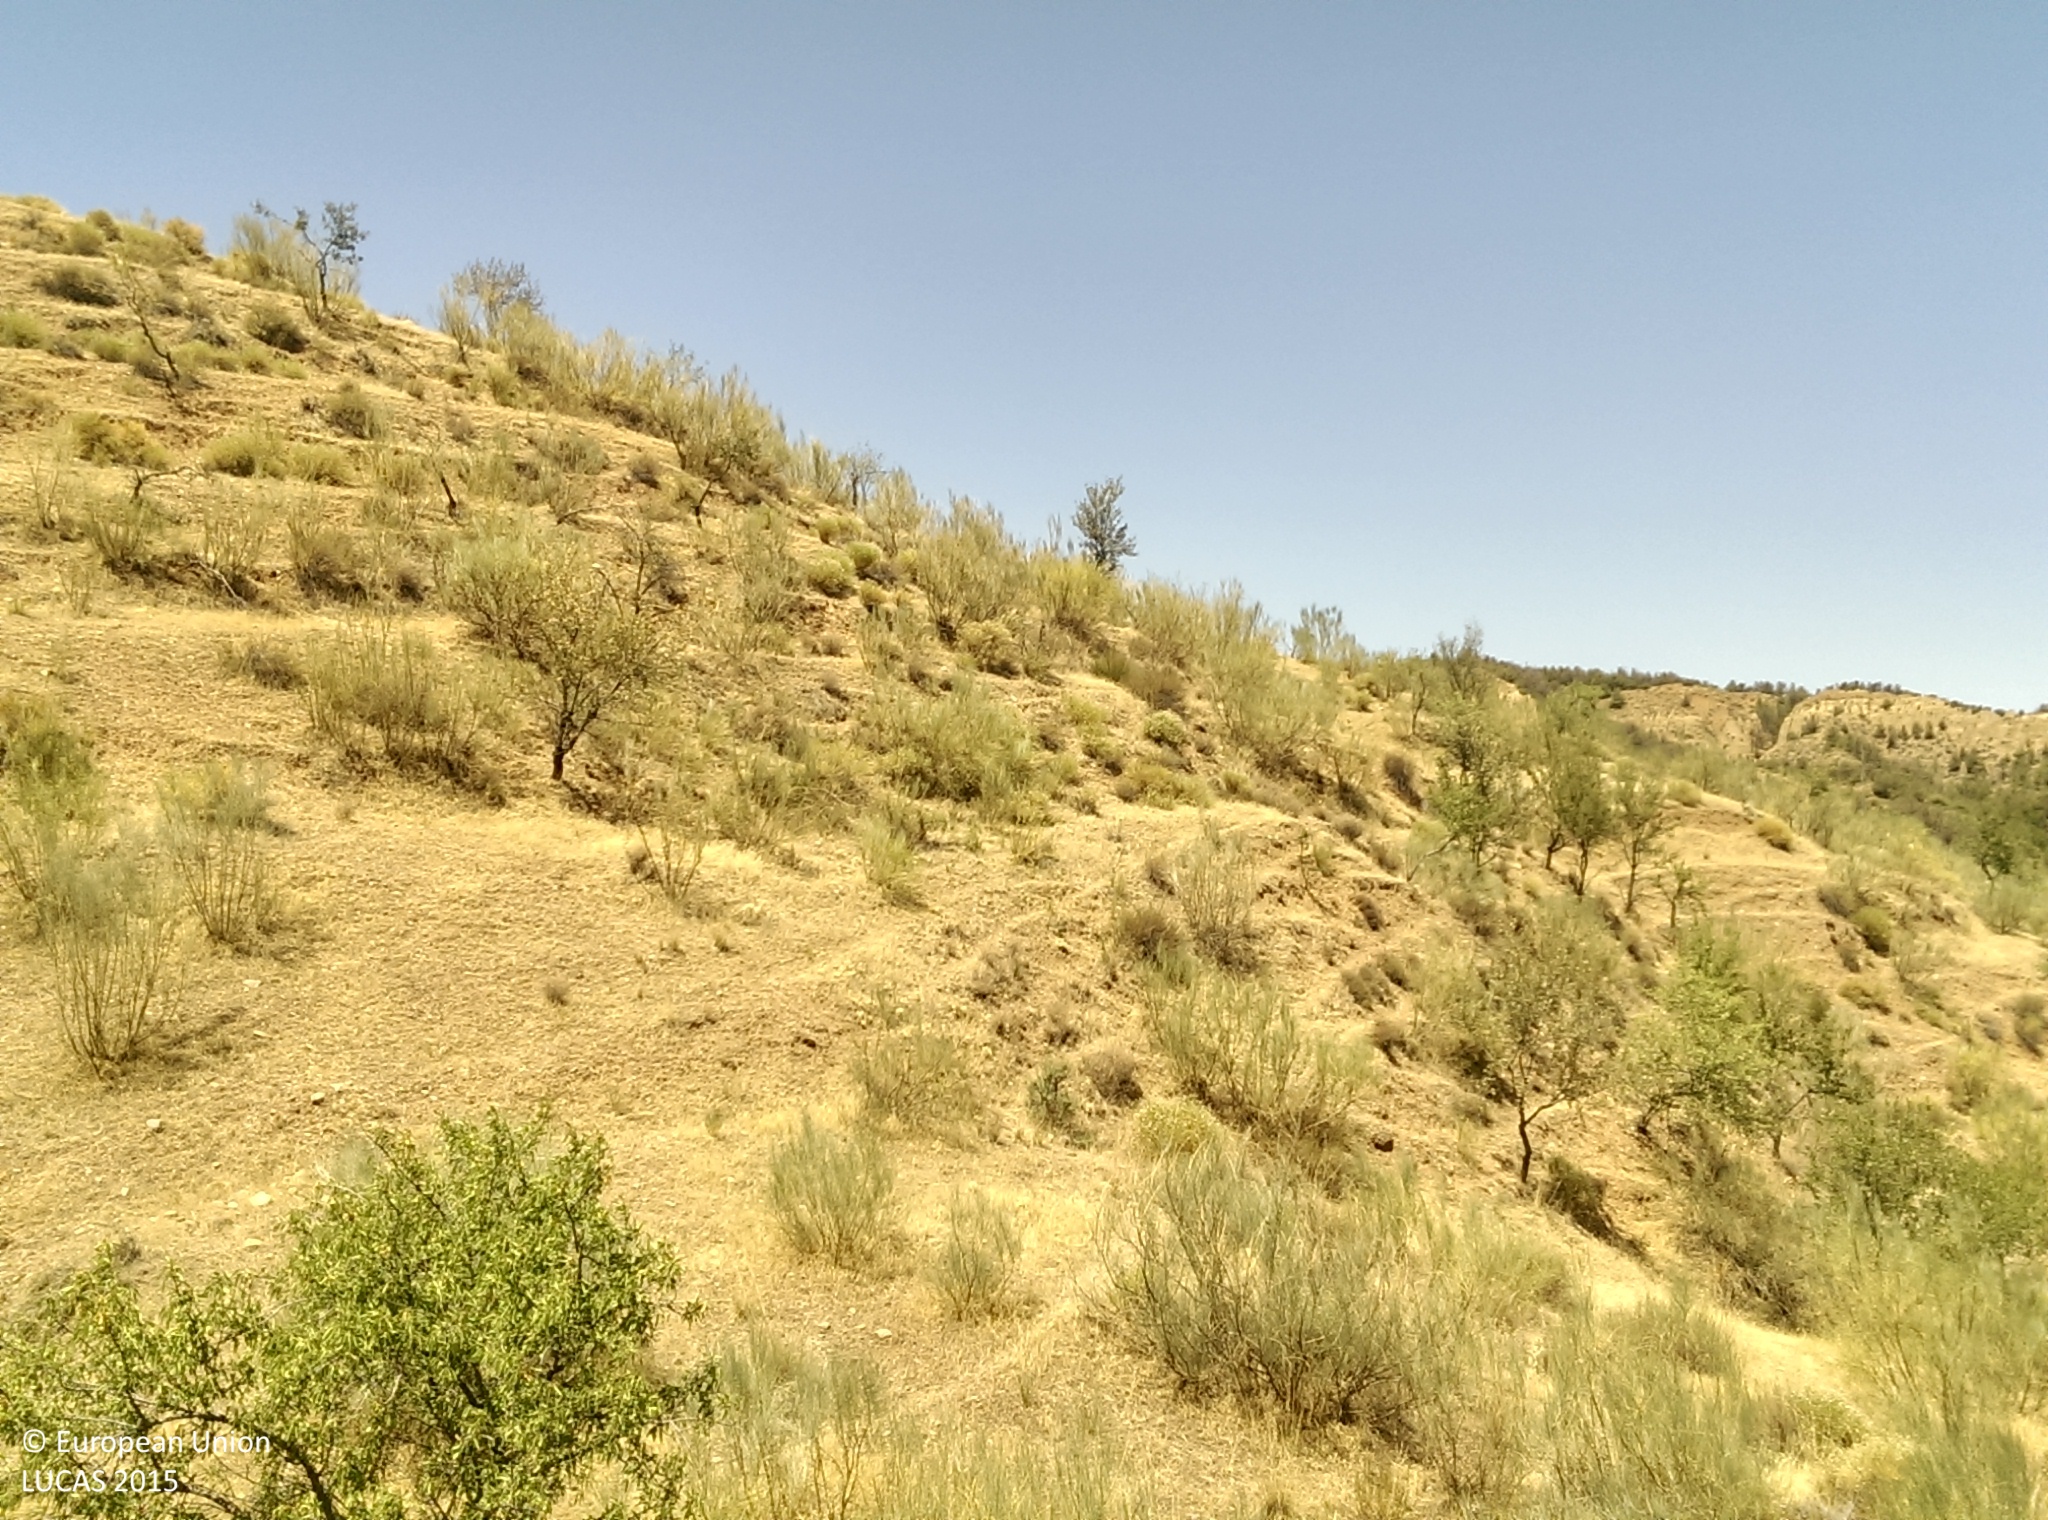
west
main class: Grassland
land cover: Grassland without tree/shrub cover
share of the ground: 50 - 75 %
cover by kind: herbaceous plants 70 %, unconsolidated bare surface 25 %, shrubs 5 %
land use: Semi-natural and natural areas not in use
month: July
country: ES
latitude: 37.2794
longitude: -3.2170
